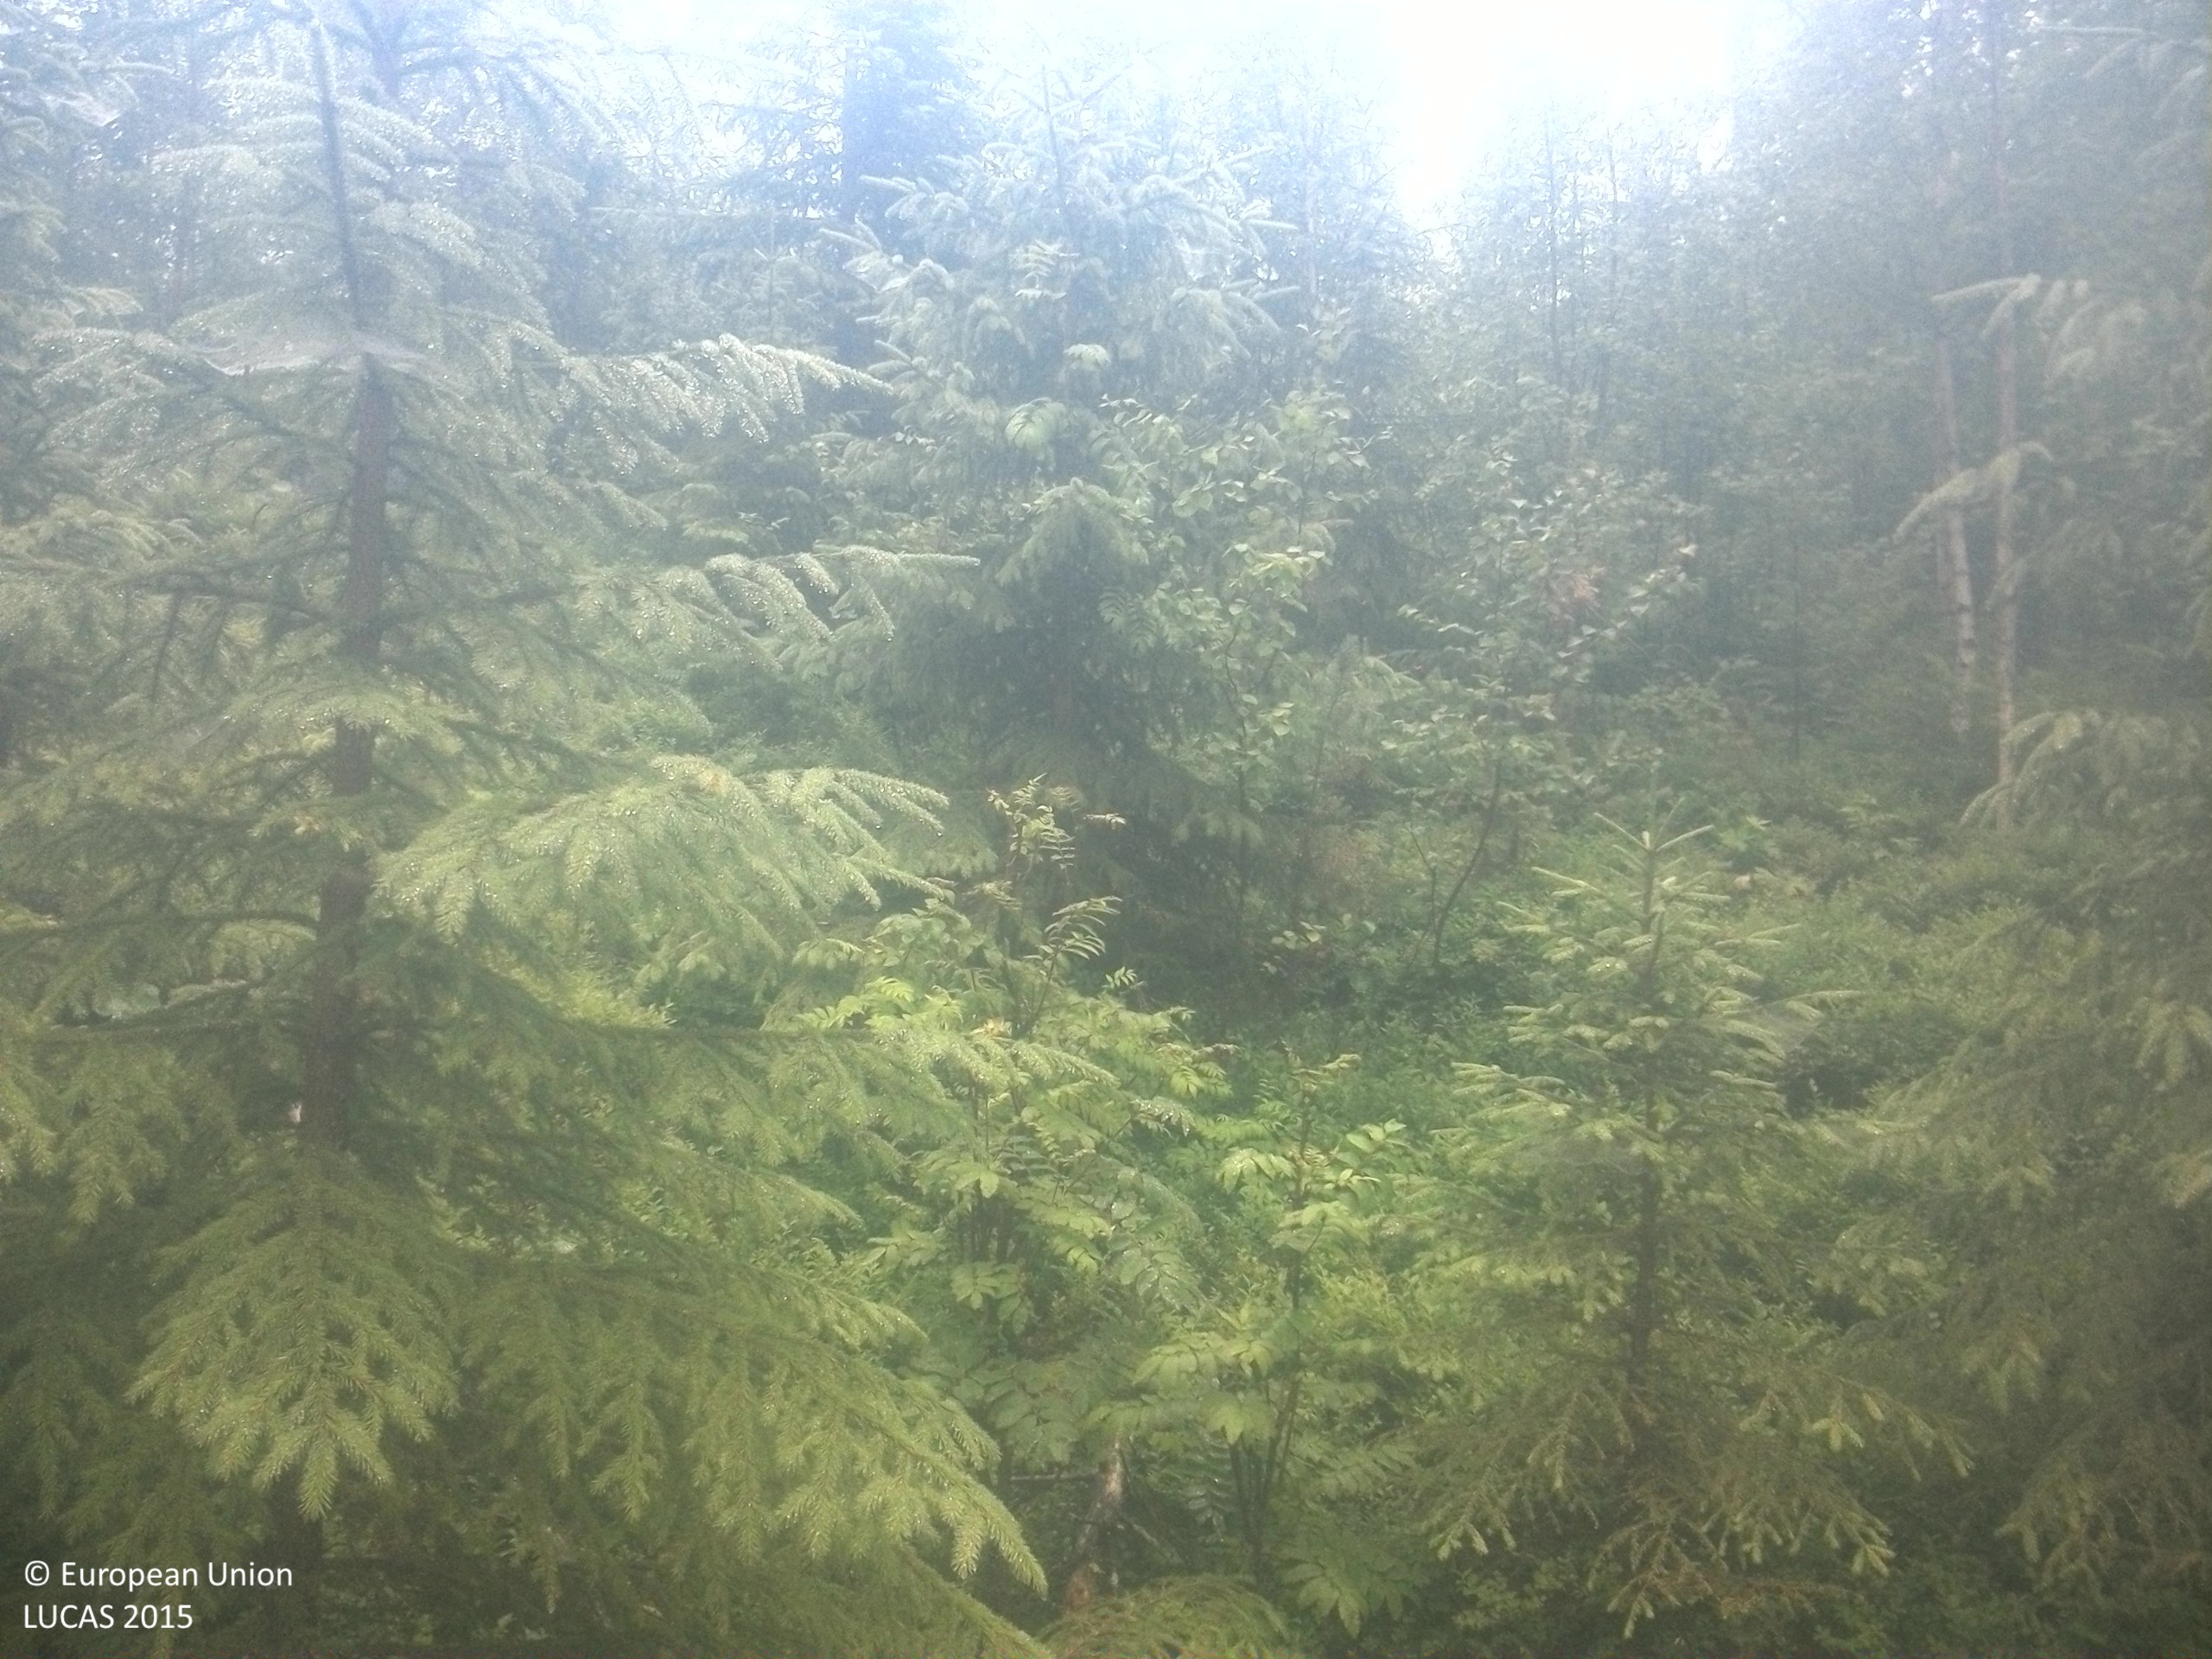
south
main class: Woodland
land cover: Spruce dominated mixed woodland
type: boreal forest
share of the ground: 50 - 75 %
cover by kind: coniferous forest trees 45 %, shrubs 20 %, broadleaved forest trees 15 %, lichens and mosses 10 %, herbaceous plants 5 %, consolidated bare surface 5 %
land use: Forestry
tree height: > 5 m
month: August
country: SE
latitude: 63.5431
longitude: 16.4315
